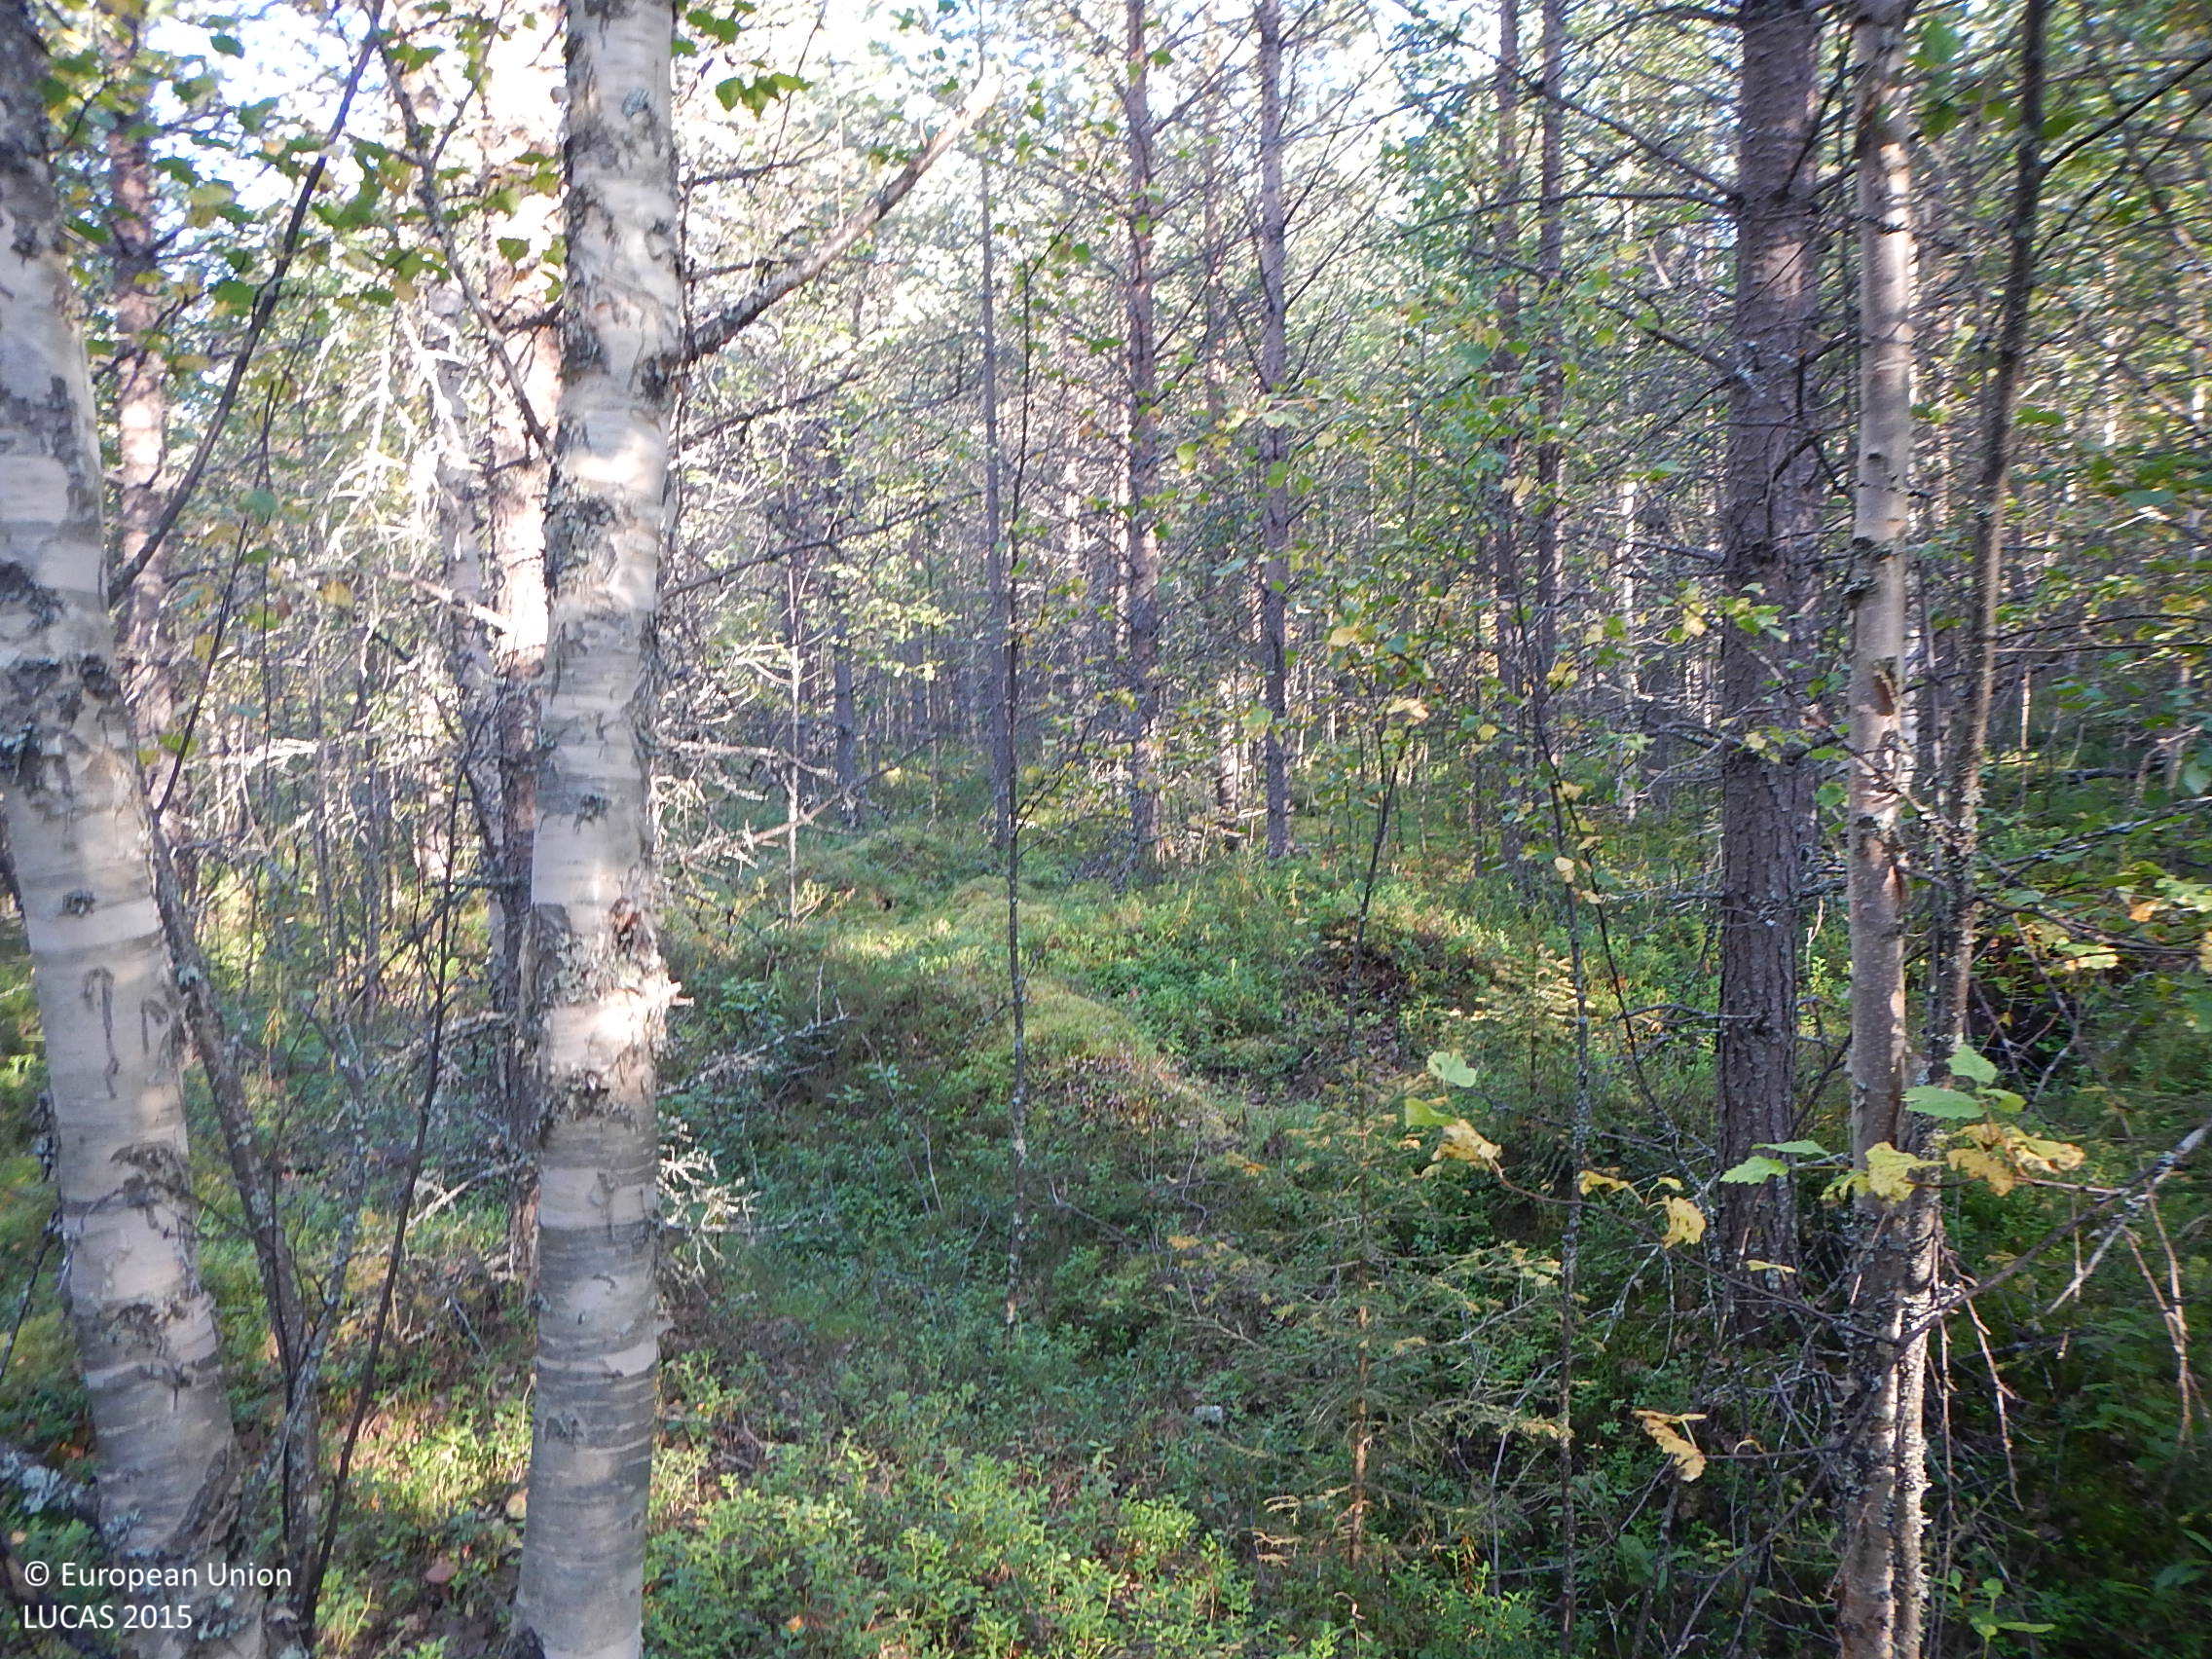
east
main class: Woodland
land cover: Pine dominated mixed woodland
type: boreal forest
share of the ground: > 75 %
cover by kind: coniferous forest trees 60 %, broadleaved forest trees 20 %, shrubs 10 %, herbaceous plants 5 %, lichens and mosses 5 %
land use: Forestry
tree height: > 5 m
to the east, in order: Pine dominated mixed woodland; Other mixed woodland
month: August
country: FI
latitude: 66.4029
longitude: 28.2963
